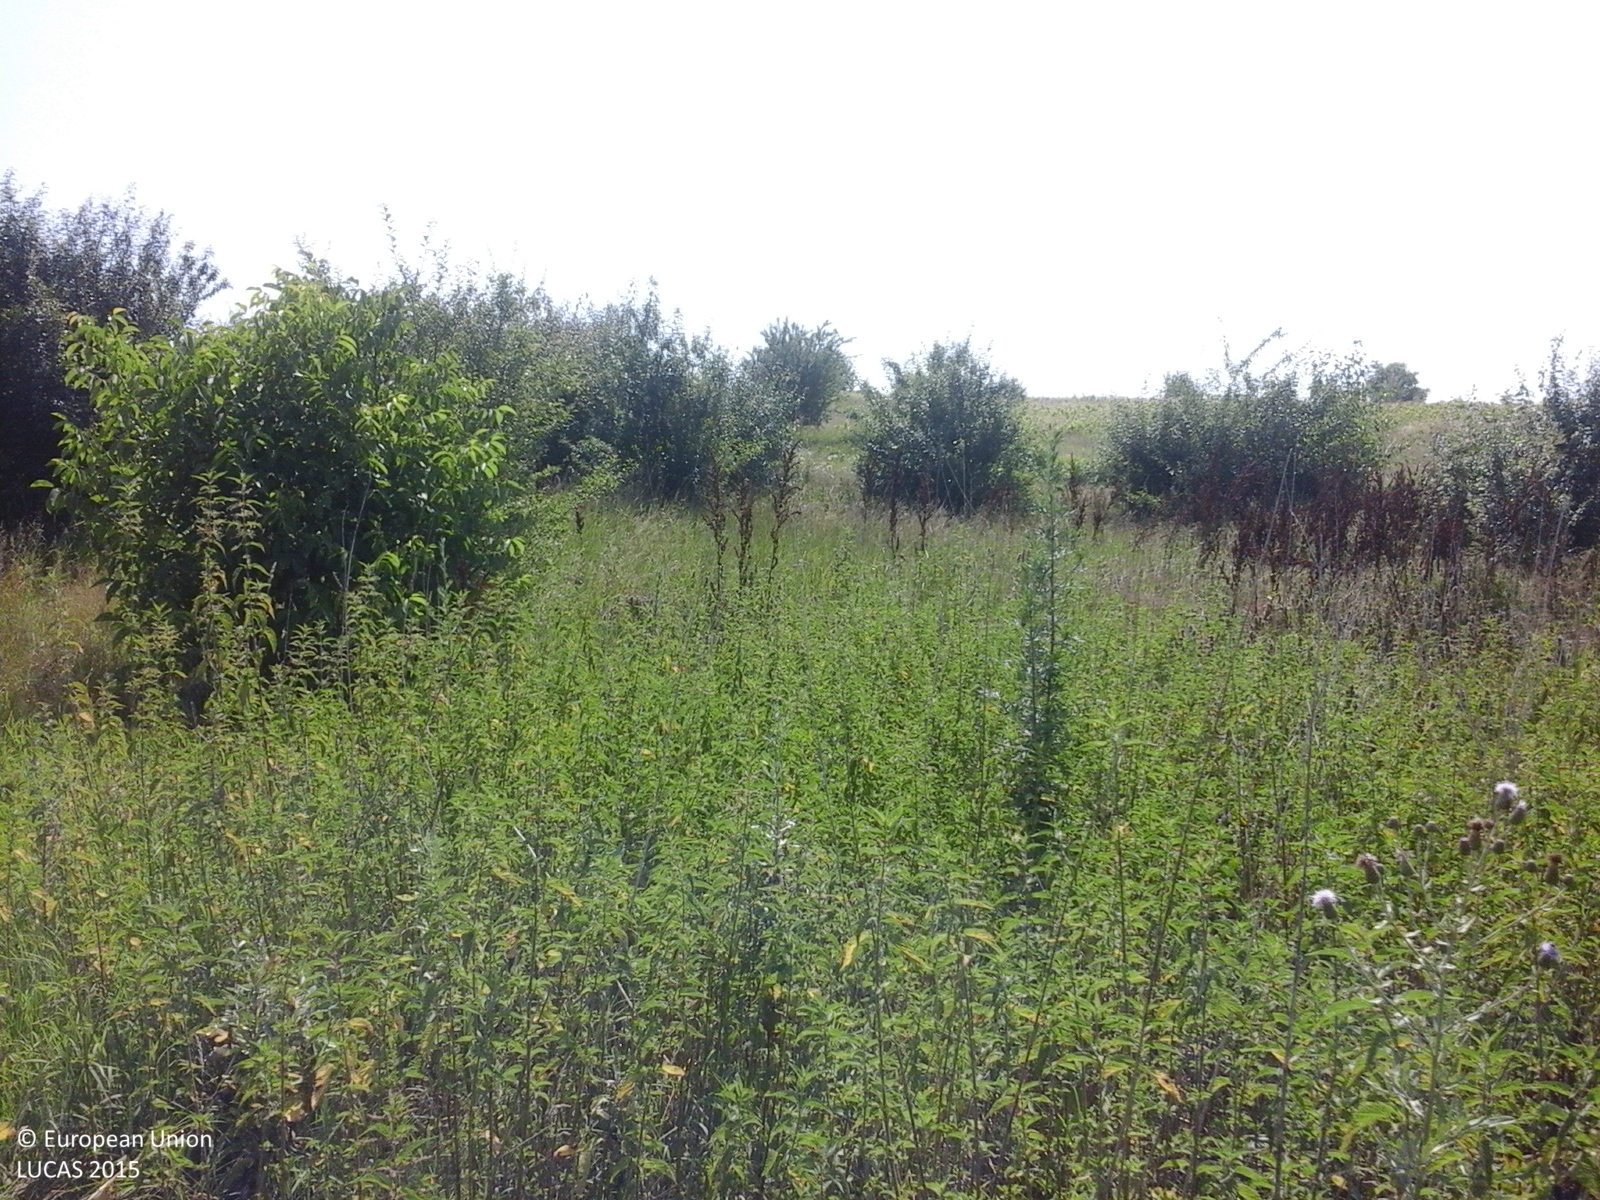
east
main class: Grassland
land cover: Grassland with sparse tree/shrub cover
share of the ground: > 75 %
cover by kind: herbaceous plants 85 %, shrubs 10 %, broadleaved forest trees 5 %
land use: Semi-natural and natural areas not in use
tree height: < 5 m
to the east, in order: Grassland with sparse tree/shrub cover; Tracks; Grassland with sparse tree/shrub cover; Vineyards; Single bushes/trees; Vineyards; Lucerne; Vineyards; Single bushes/trees; Vineyards; Grassland without tree/shrub cover; Vineyards; Tracks; Vineyards; Single bushes/trees; Vineyards
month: July
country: RO
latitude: 44.1741
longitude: 25.8177
